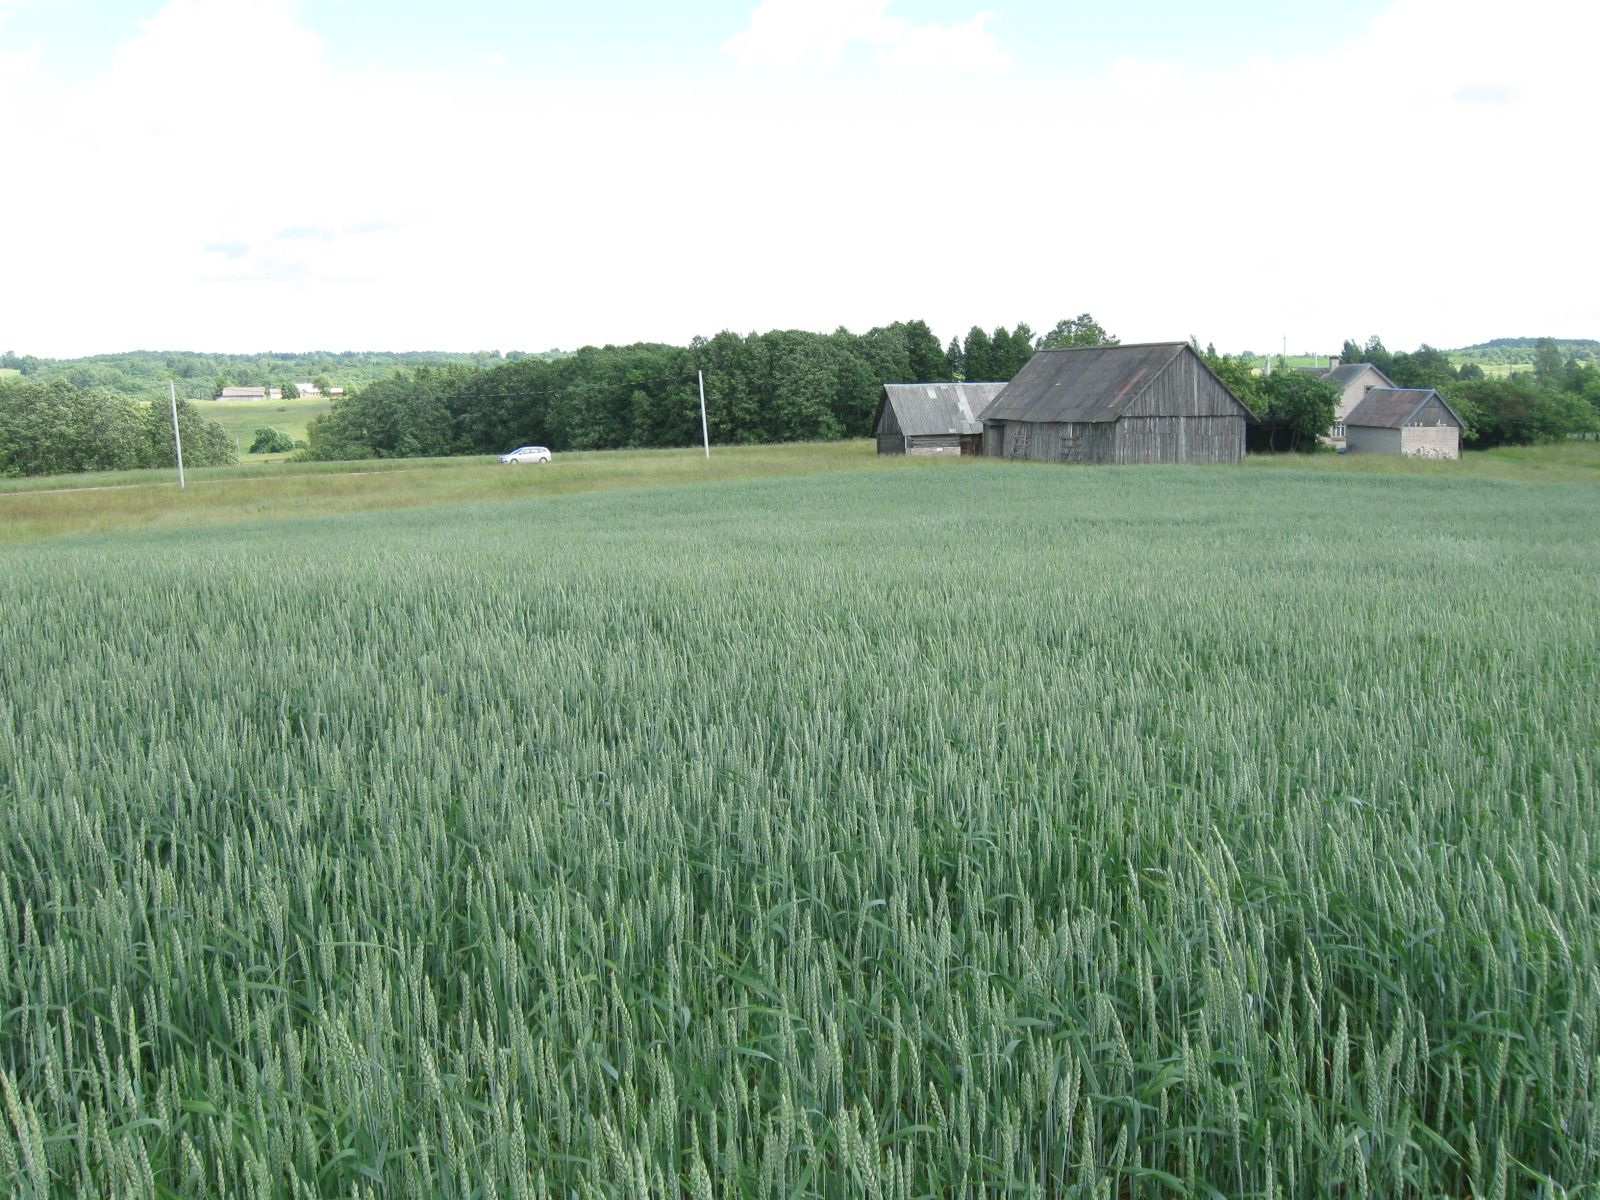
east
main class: Cropland
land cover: Common wheat
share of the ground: > 75 %
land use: Agriculture (excluding fallow land and kitchen gardens)
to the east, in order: Common wheat; Grassland without tree/shrub cover; Potatoes; Grassland without tree/shrub cover; Electric lines; Grassland without tree/shrub cover; Paved roads, cycling and walking lanes; Grass margins; Common wheat; Grassland without tree/shrub cover; Broadleaved woodland; Rivers and streams; Broadleaved woodland
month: June
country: LT
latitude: 54.6516
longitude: 24.4377
